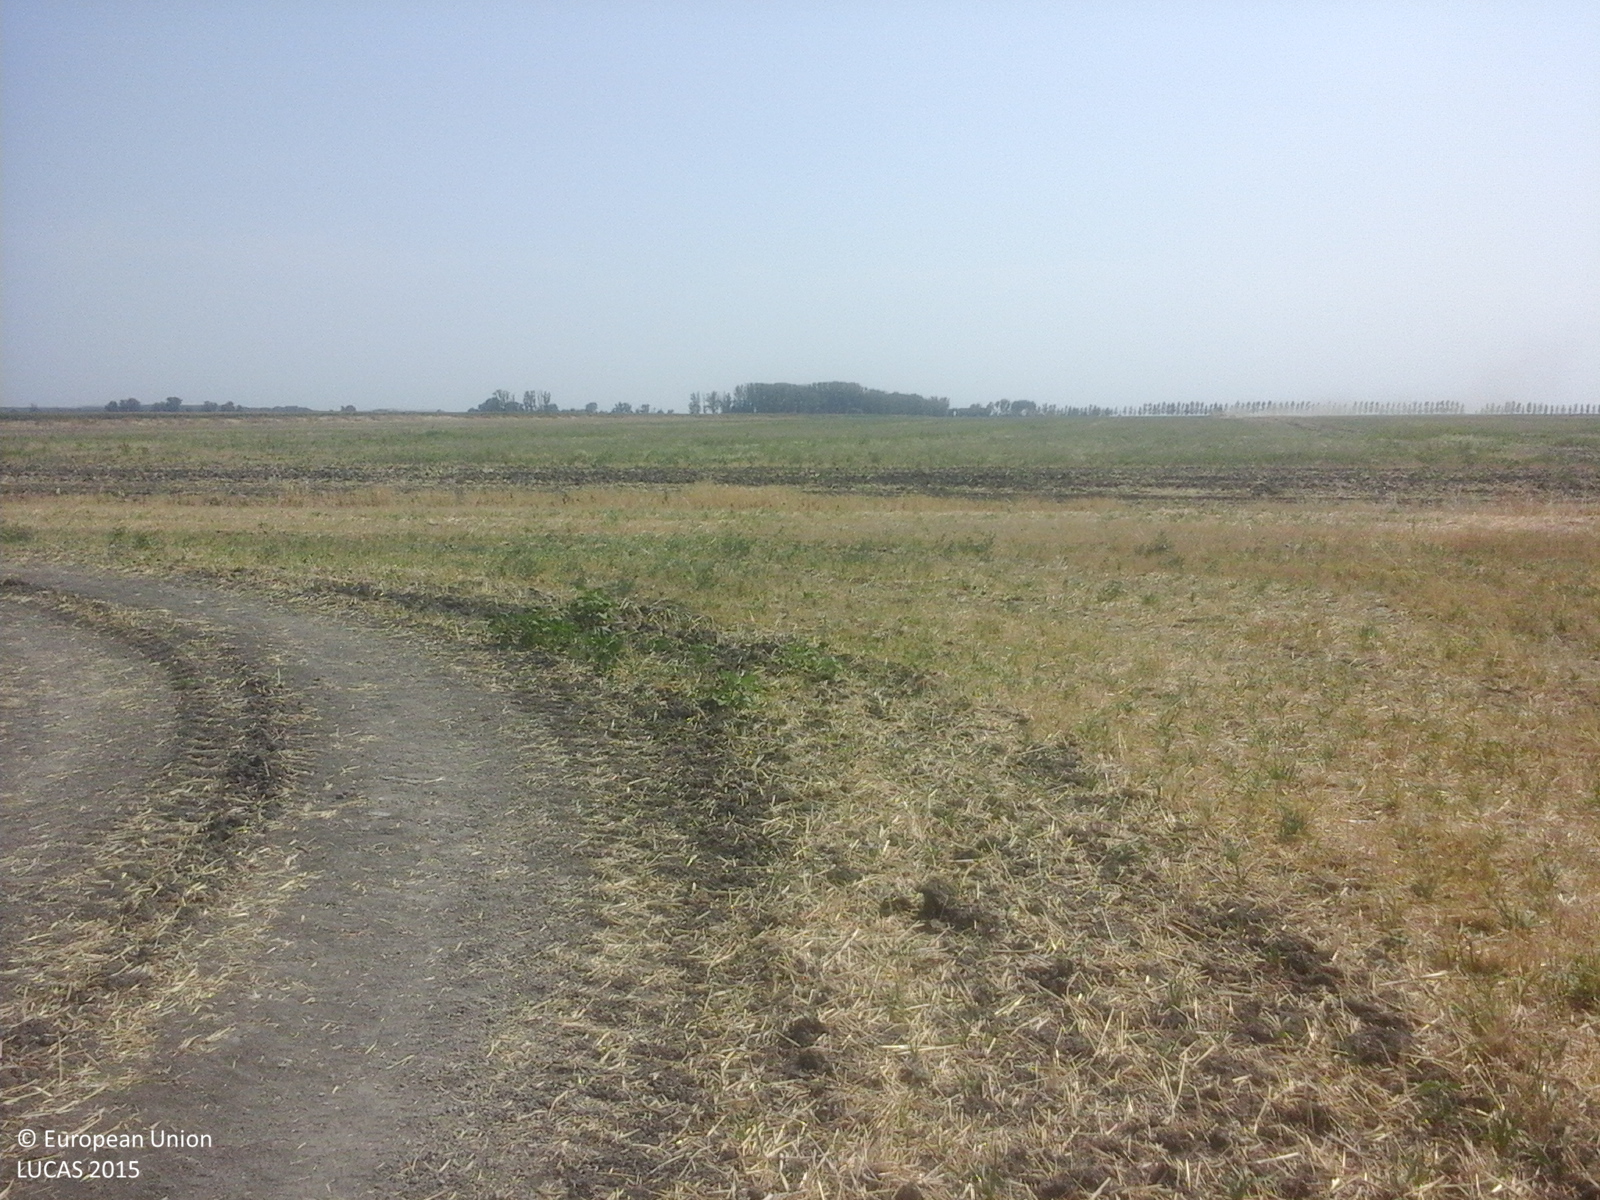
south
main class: Cropland
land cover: Common wheat
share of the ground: 50 - 75 %
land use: Agriculture (excluding fallow land and kitchen gardens)
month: August
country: RO
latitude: 45.1386
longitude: 28.1116
